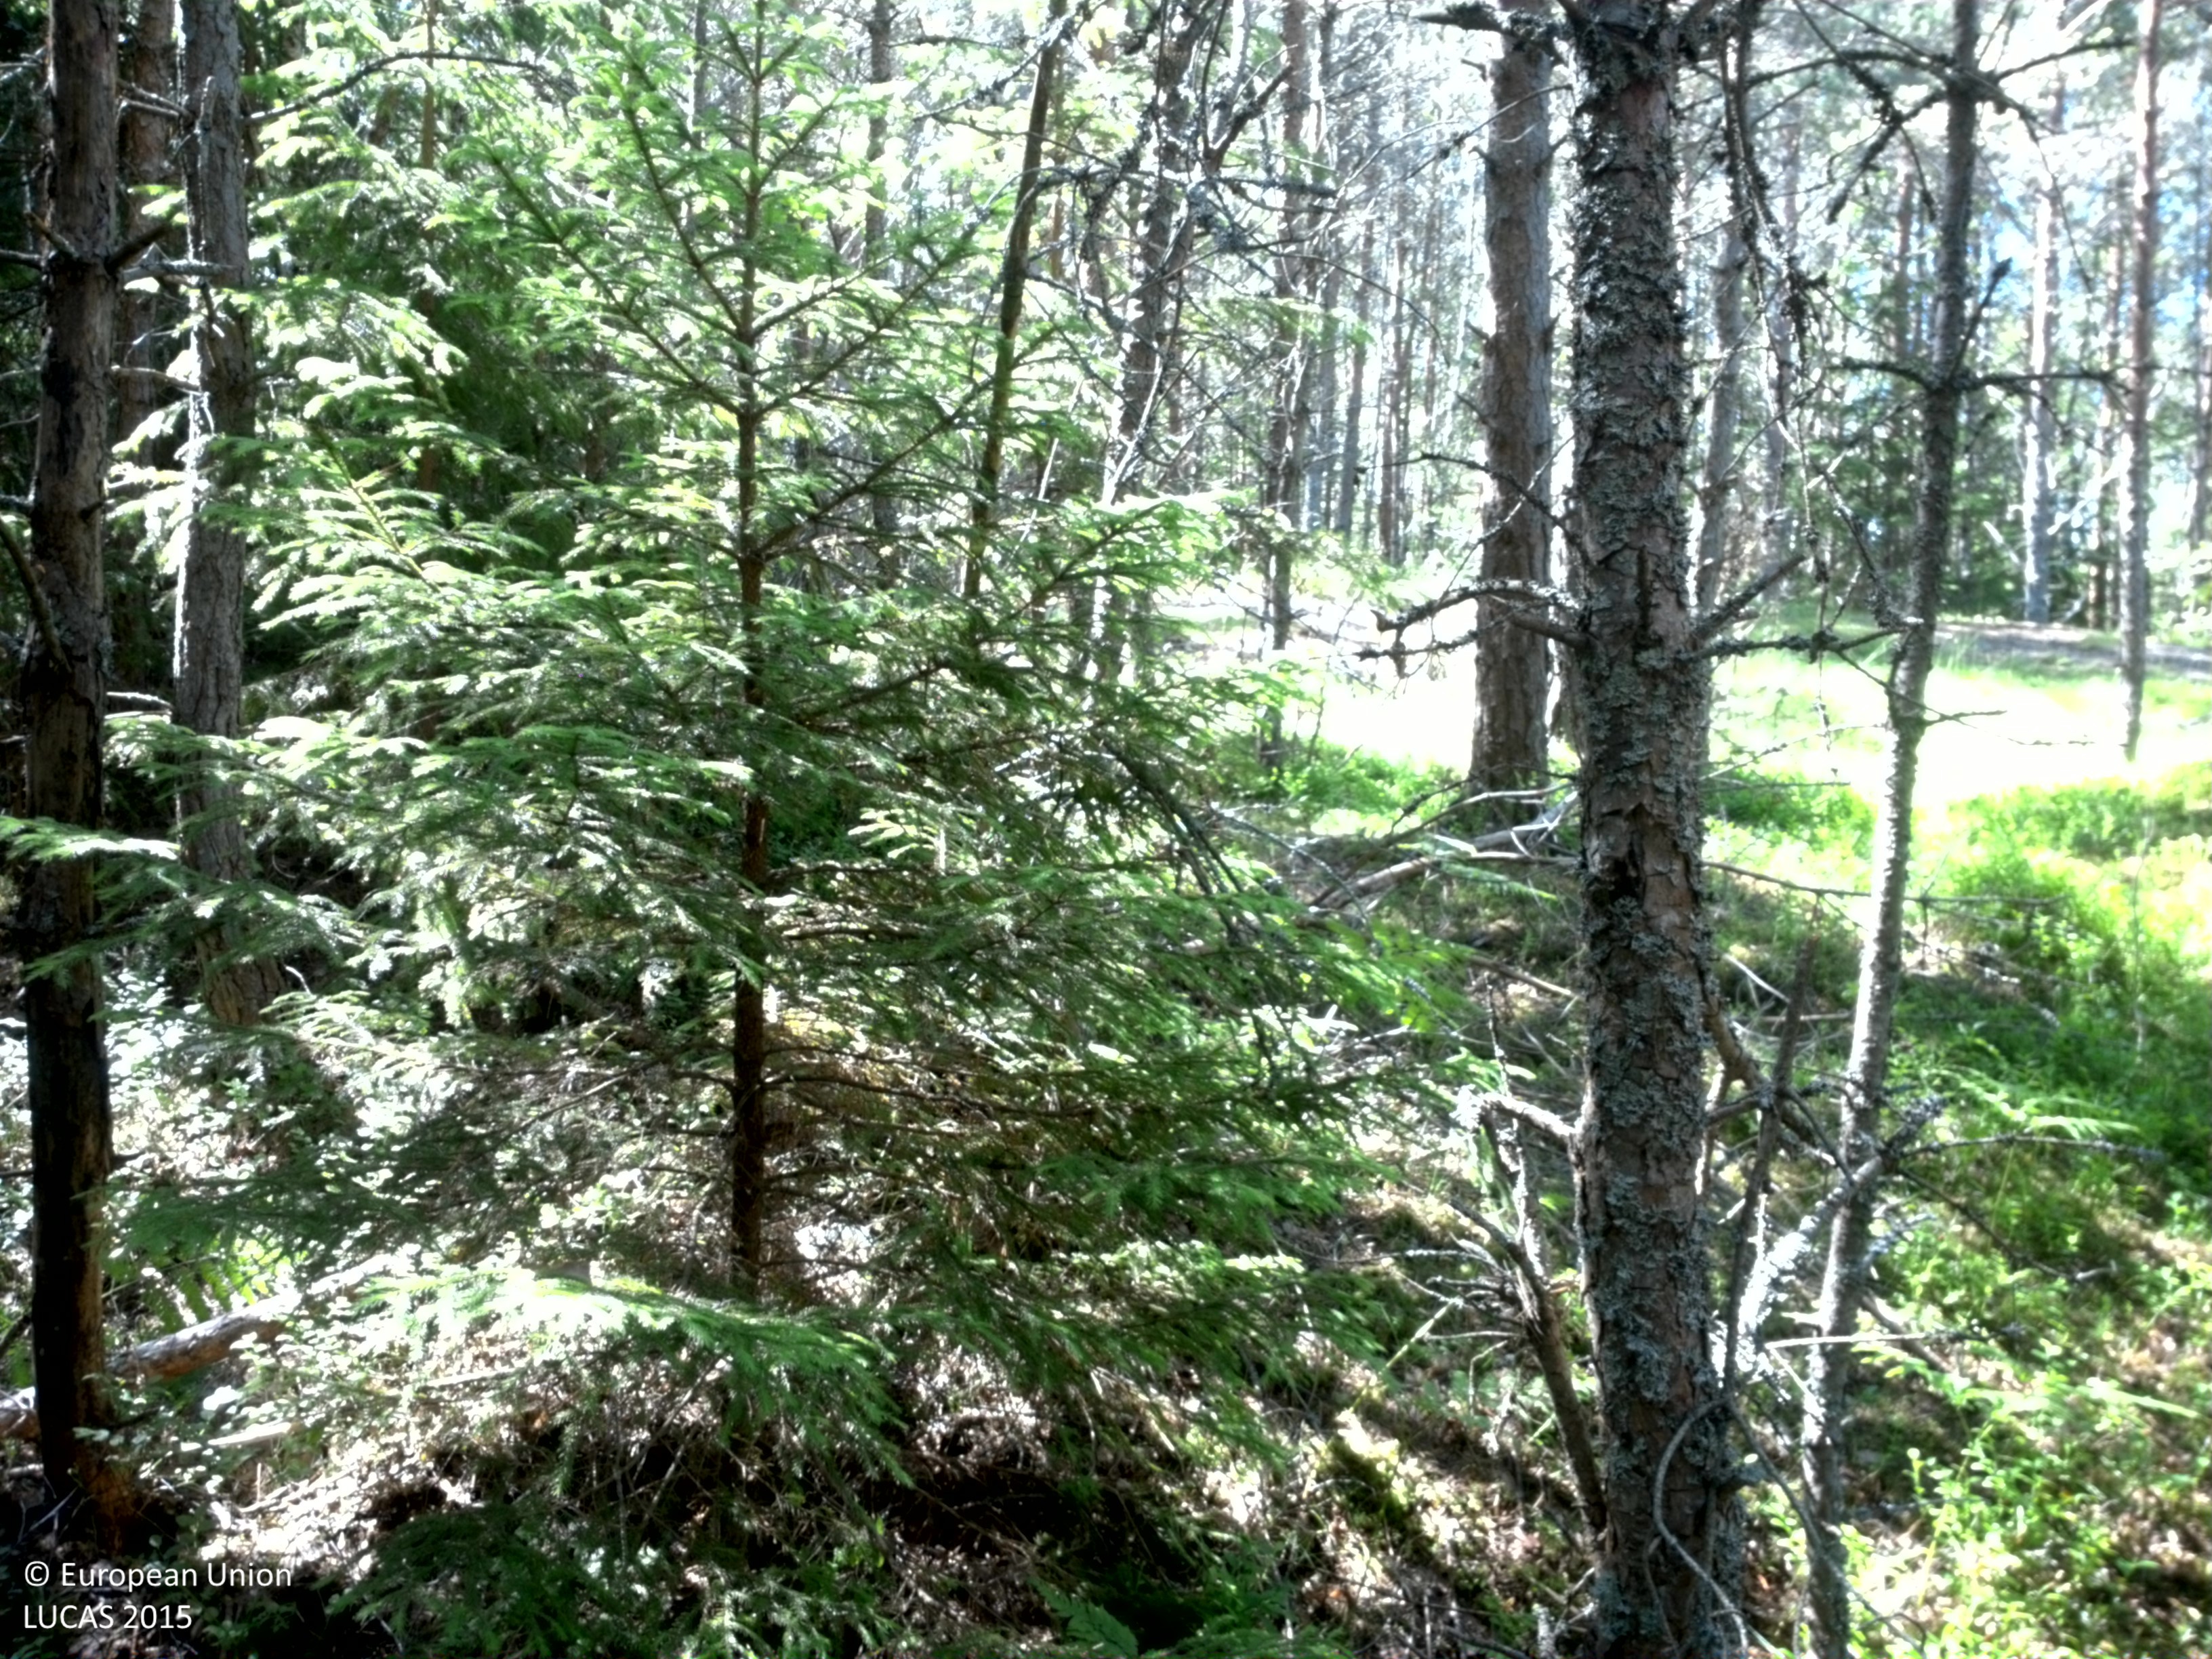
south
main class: Woodland
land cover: Pine dominated mixed woodland
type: boreal forest
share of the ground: 50 - 75 %
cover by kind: coniferous forest trees 35 %, herbaceous plants 30 %, broadleaved forest trees 25 %, lichens and mosses 10 %
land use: Forestry
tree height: > 5 m
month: June
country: SE
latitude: 58.5602
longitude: 15.4427
